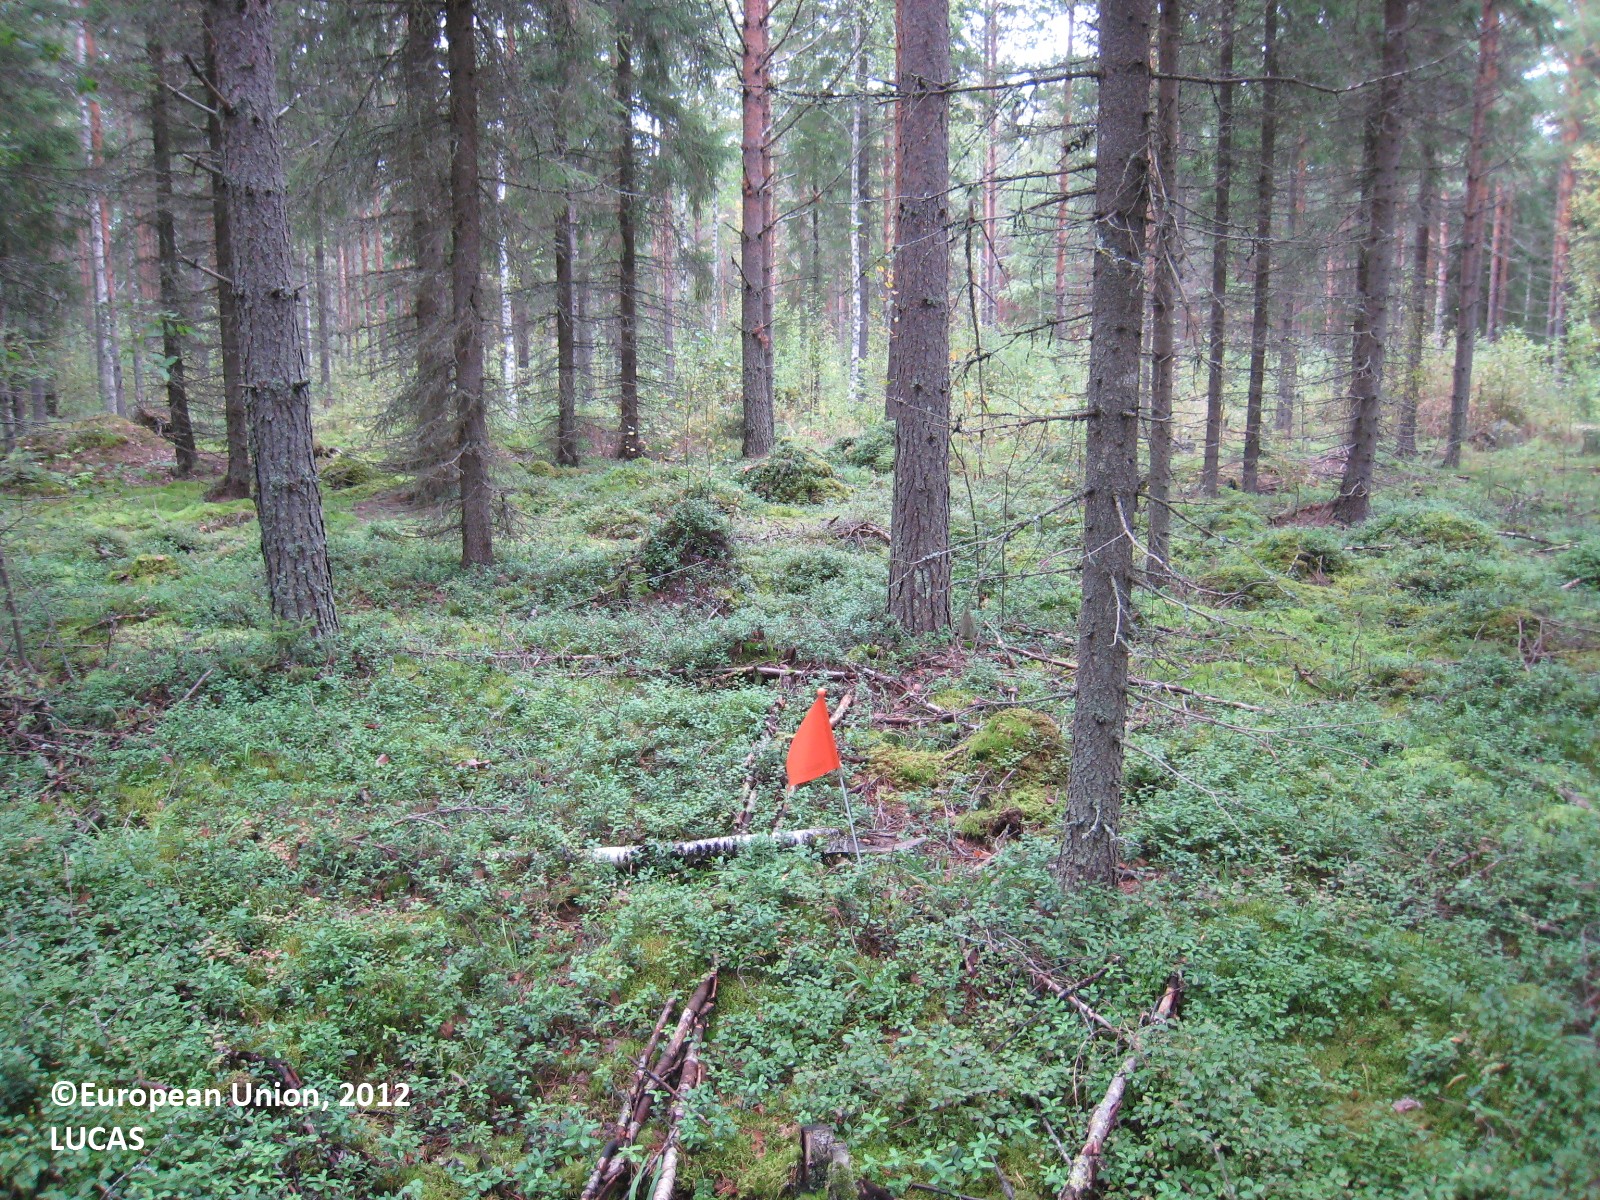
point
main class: Woodland
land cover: Other coniferous woodland
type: boreal forest
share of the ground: 50 - 75 %
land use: Forestry
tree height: > 5 m
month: August
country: FI
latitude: 62.1199
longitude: 27.1243
